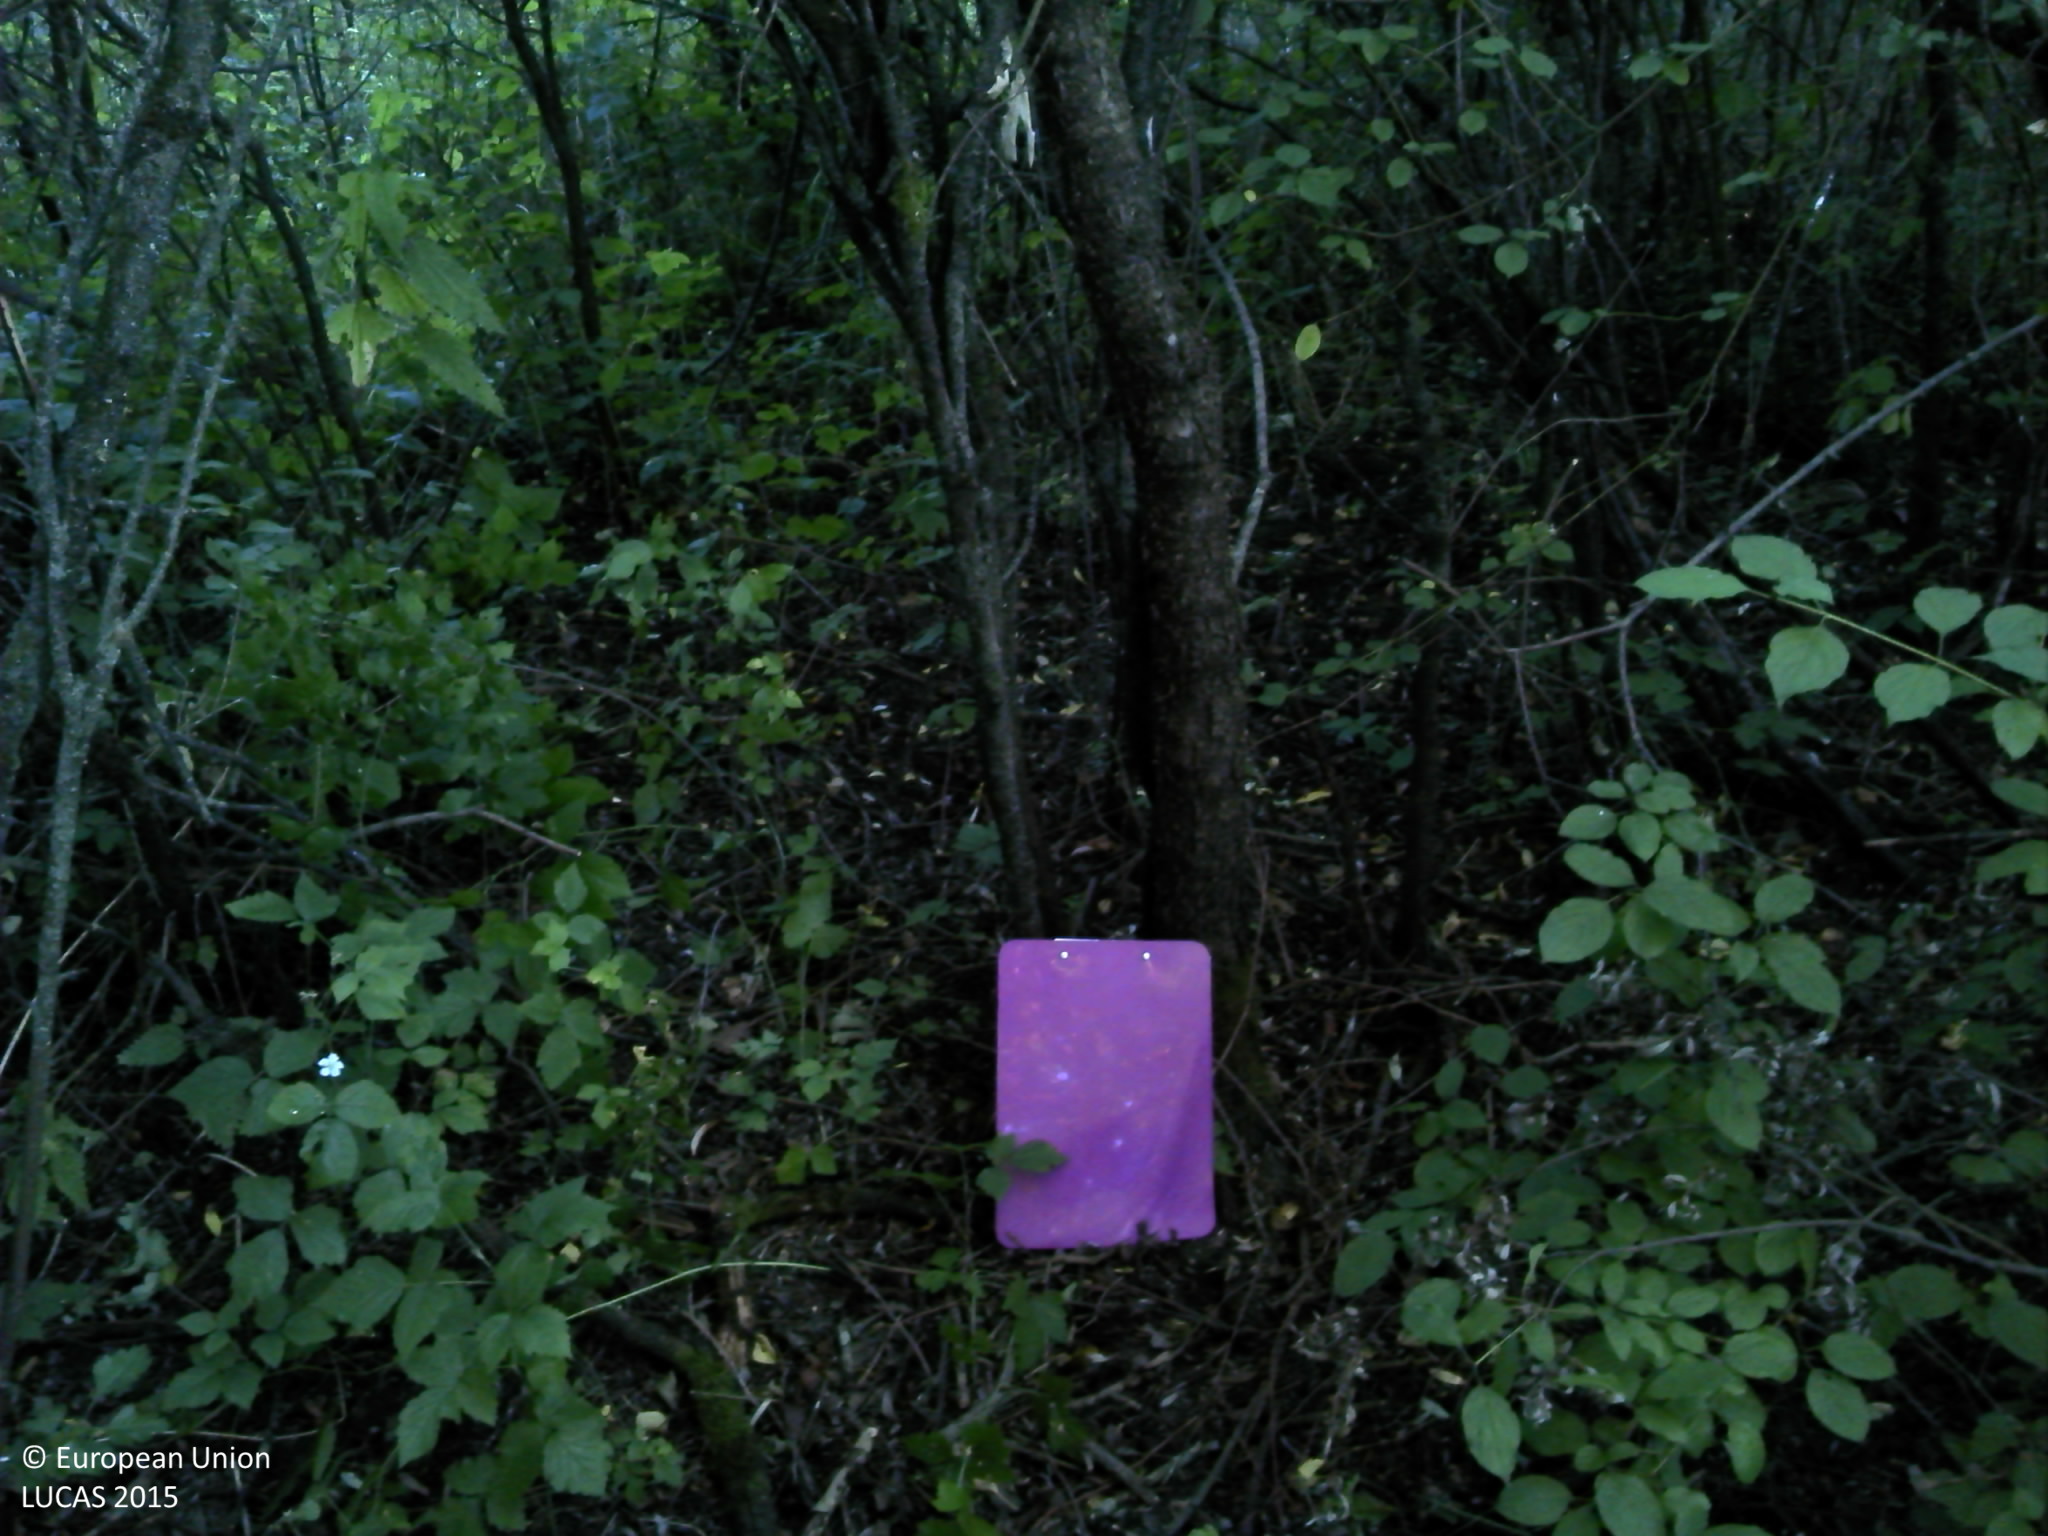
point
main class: Shrubland
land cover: Shrubland with sparse tree cover
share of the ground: > 75 %
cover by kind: shrubs 95 %, broadleaved forest trees 5 %
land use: Semi-natural and natural areas not in use
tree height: < 5 m
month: July
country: HR
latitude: 45.3915
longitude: 16.8324
